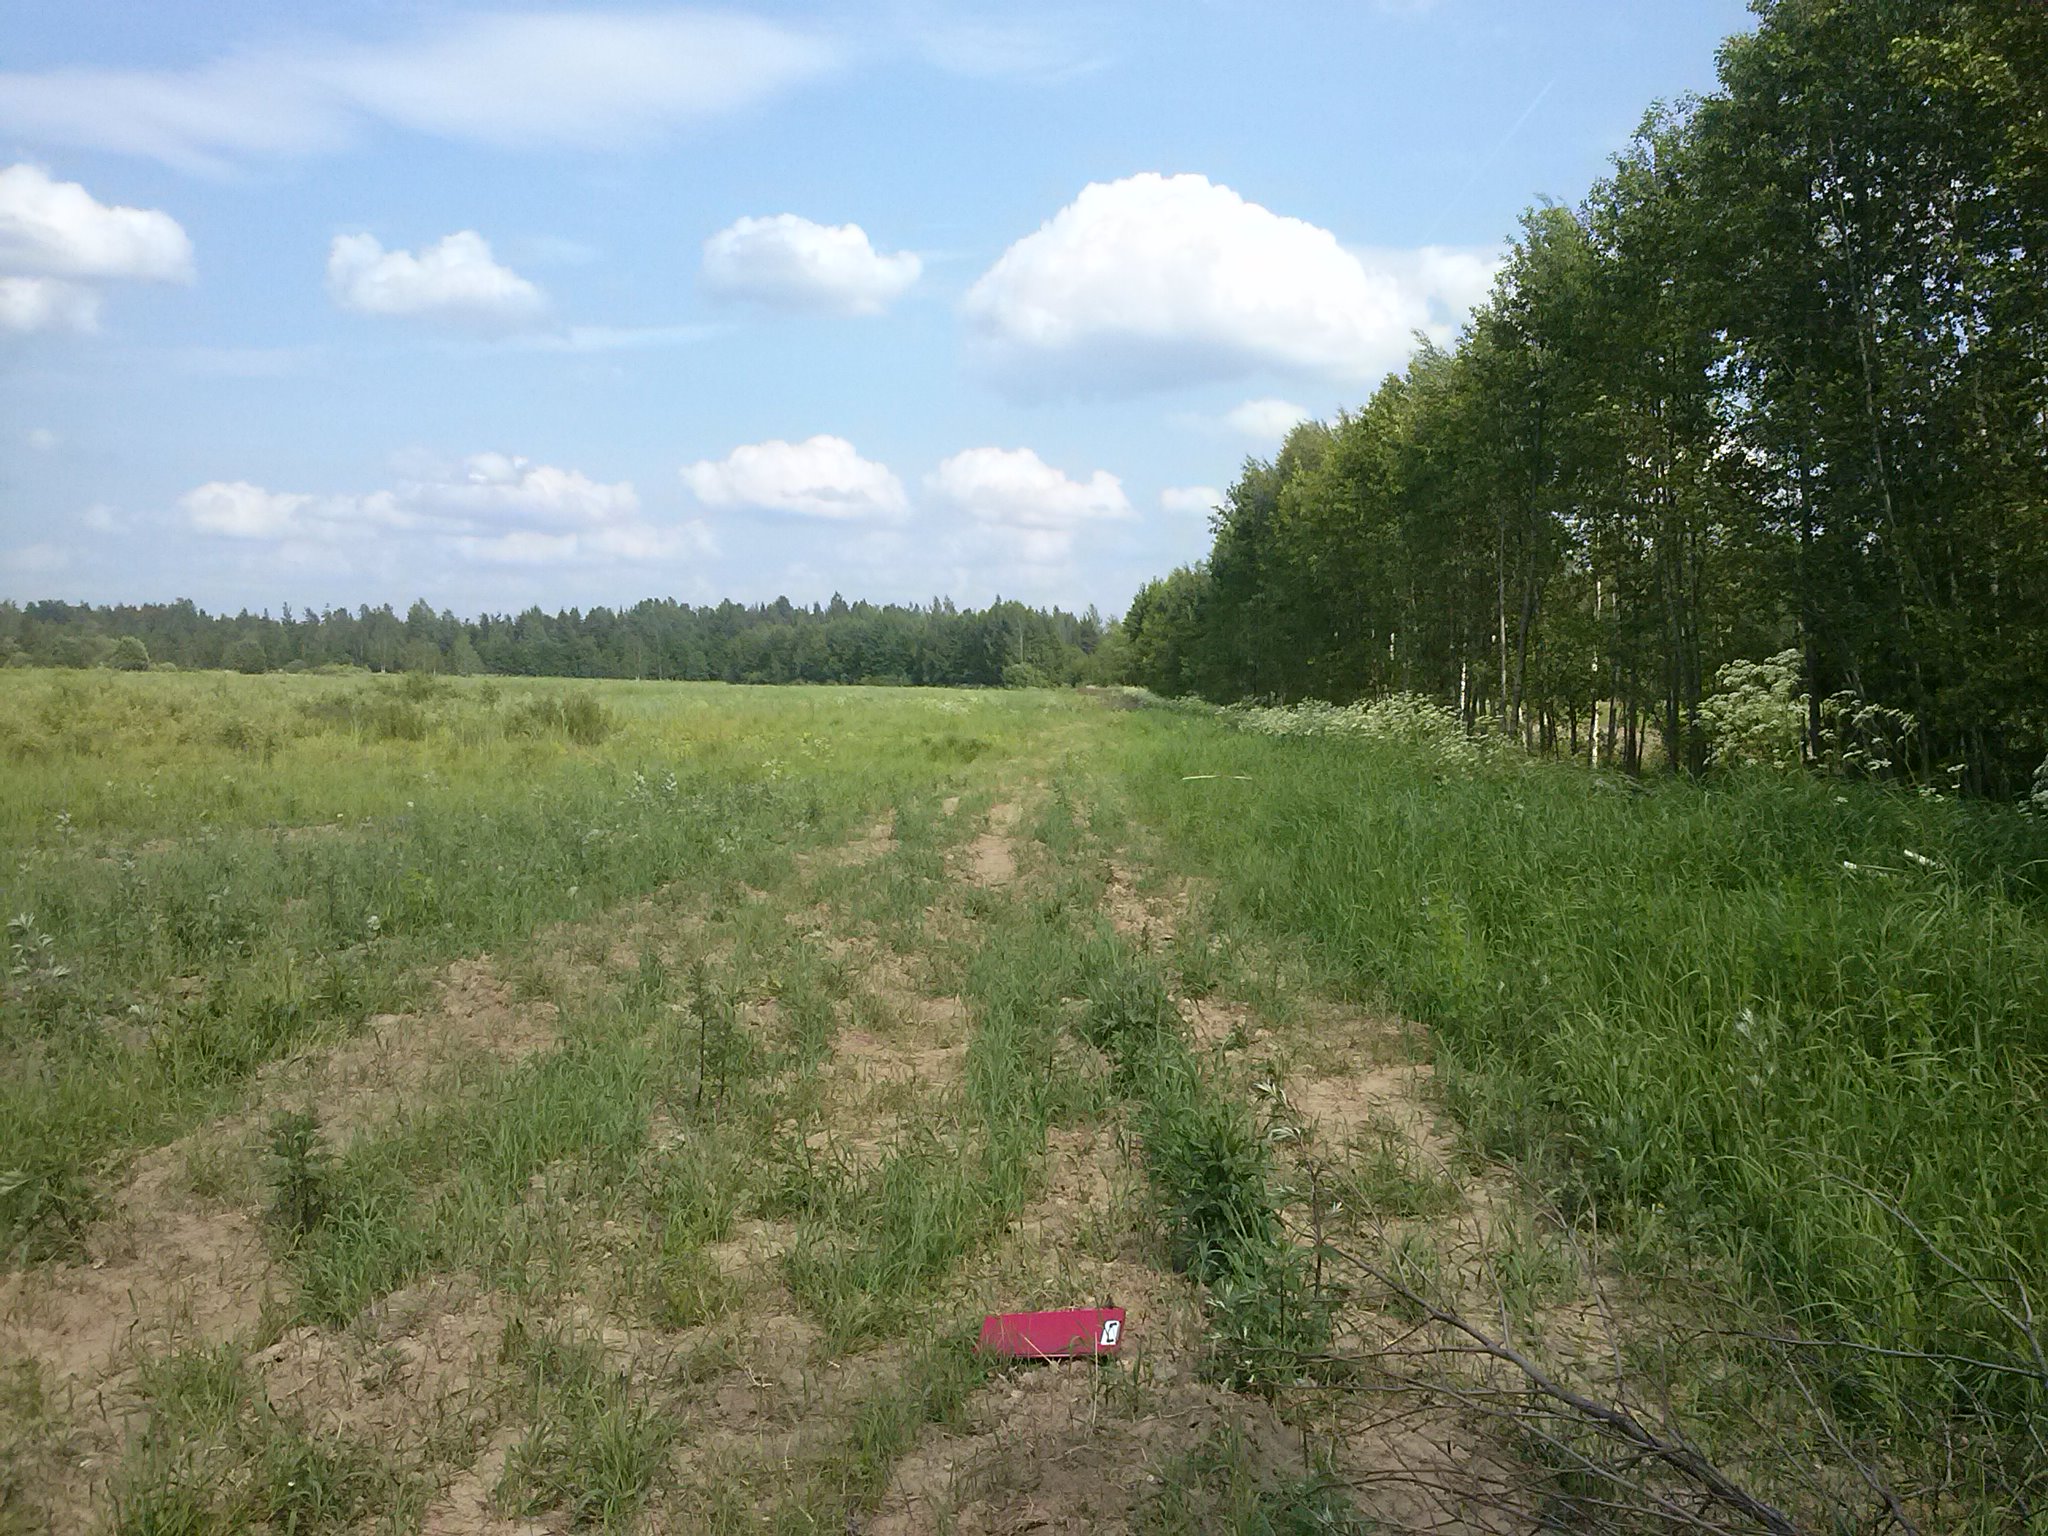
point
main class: Grassland
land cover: Grassland without tree/shrub cover
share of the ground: 50 - 75 %
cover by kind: herbaceous plants 70 %, unconsolidated bare surface 30 %
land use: Agriculture (excluding fallow land and kitchen gardens)
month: June
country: LV
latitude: 56.8606
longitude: 27.1751
